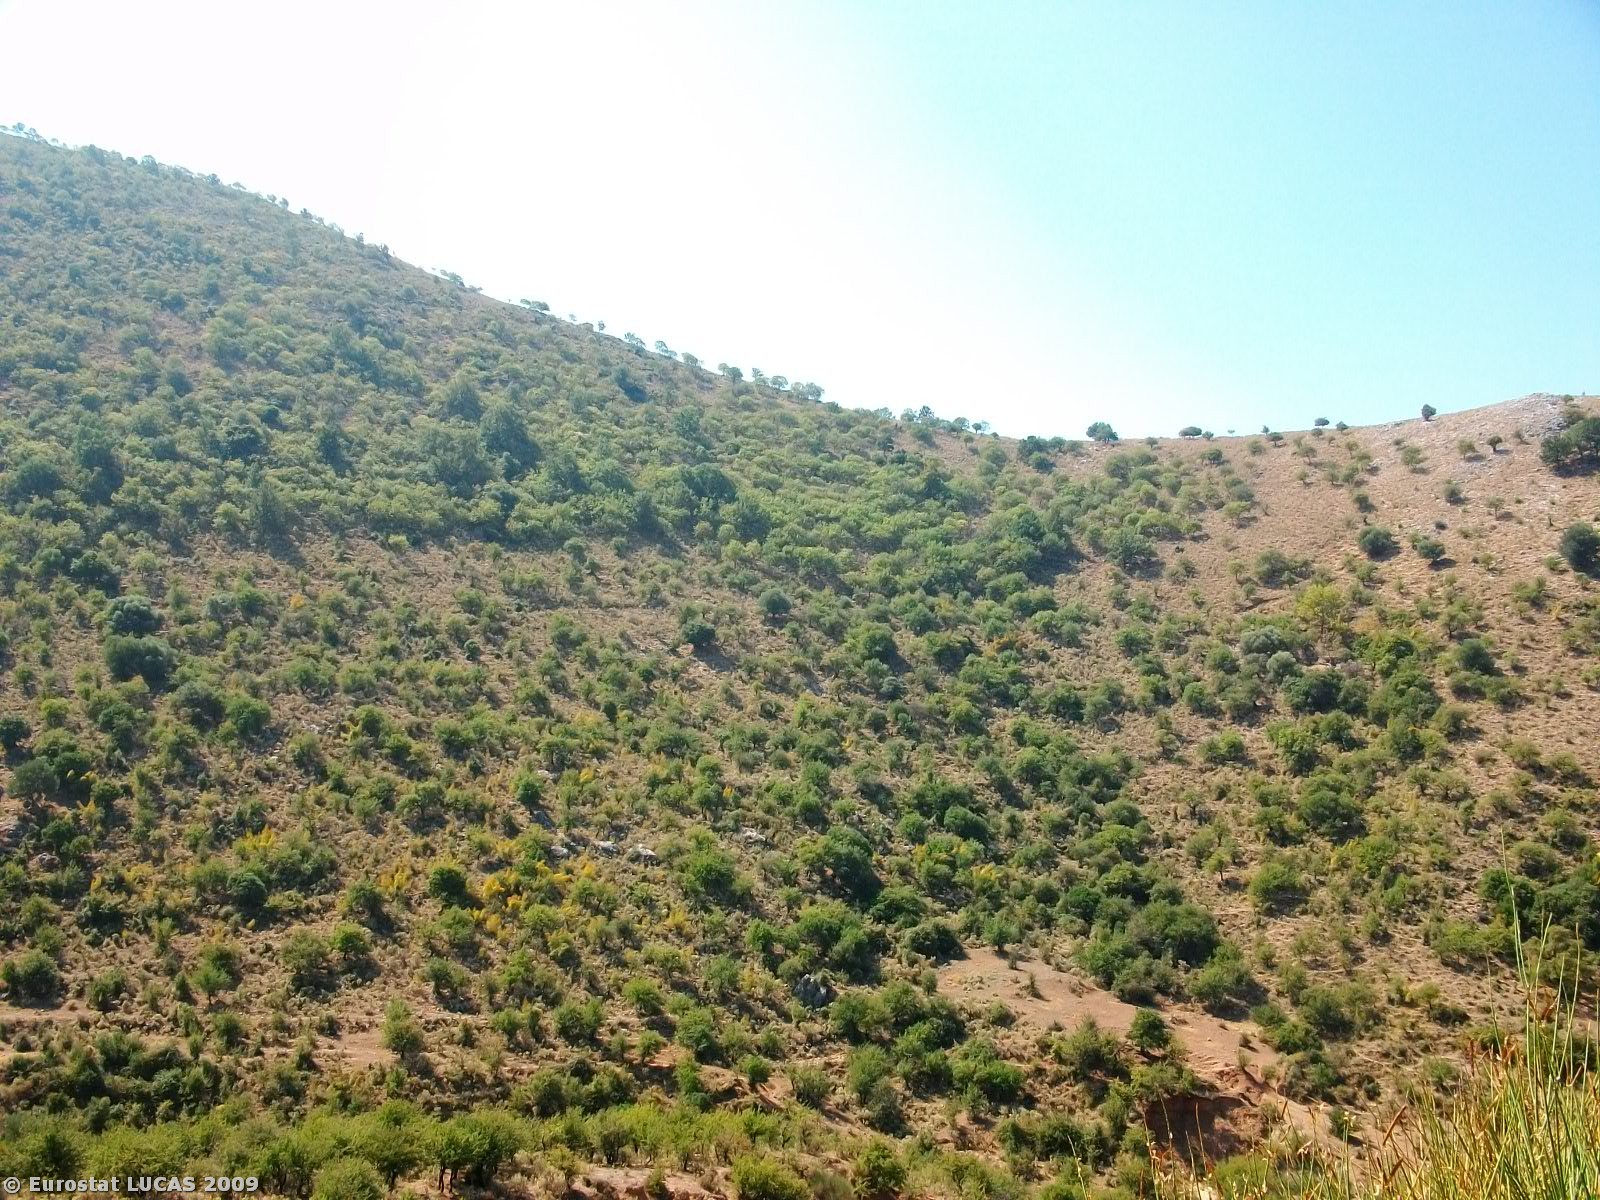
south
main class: Grassland
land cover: Grassland with sparse tree/shrub cover
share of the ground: 50 - 75 %
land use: Agriculture (excluding fallow land and kitchen gardens)
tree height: < 5 m
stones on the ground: 25 - 50 %
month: September
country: GR
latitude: 39.5061
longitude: 20.2898
